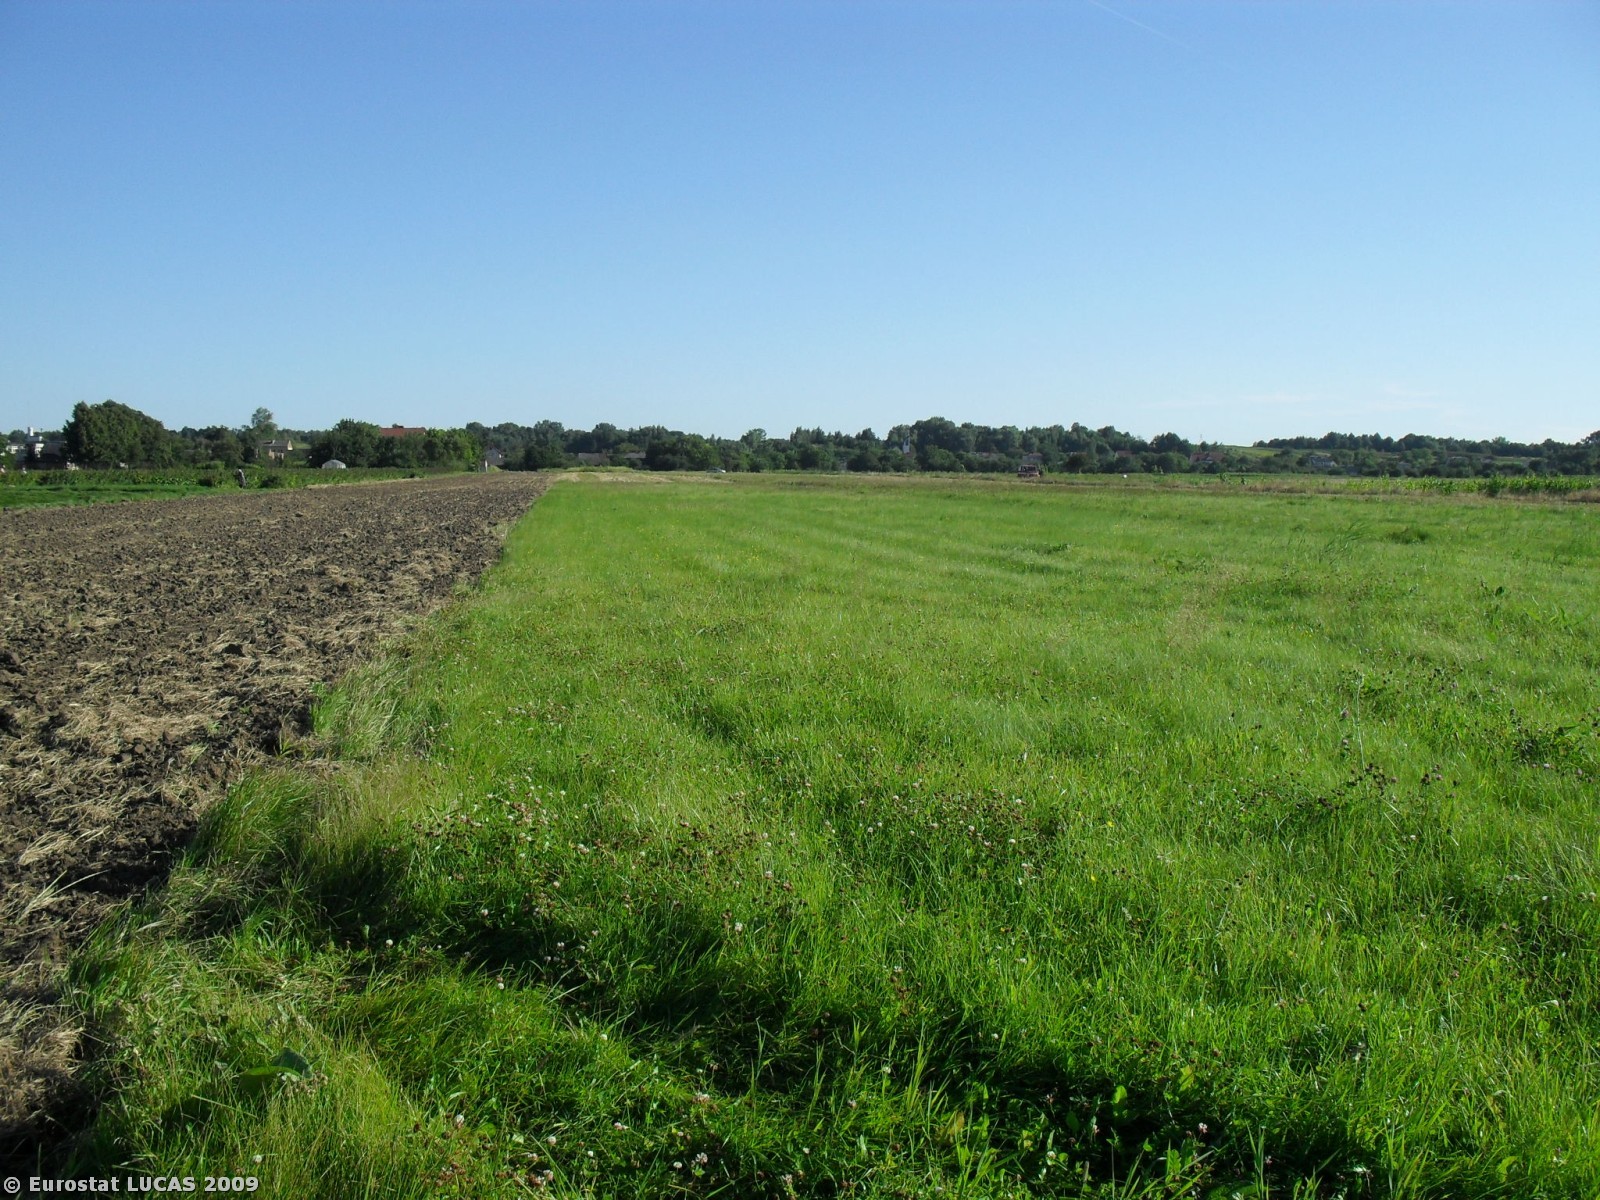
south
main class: Grassland
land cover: Grassland without tree/shrub cover
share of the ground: > 75 %
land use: Agriculture (excluding fallow land and kitchen gardens)
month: August
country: PL
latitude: 51.3991
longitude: 22.0323
